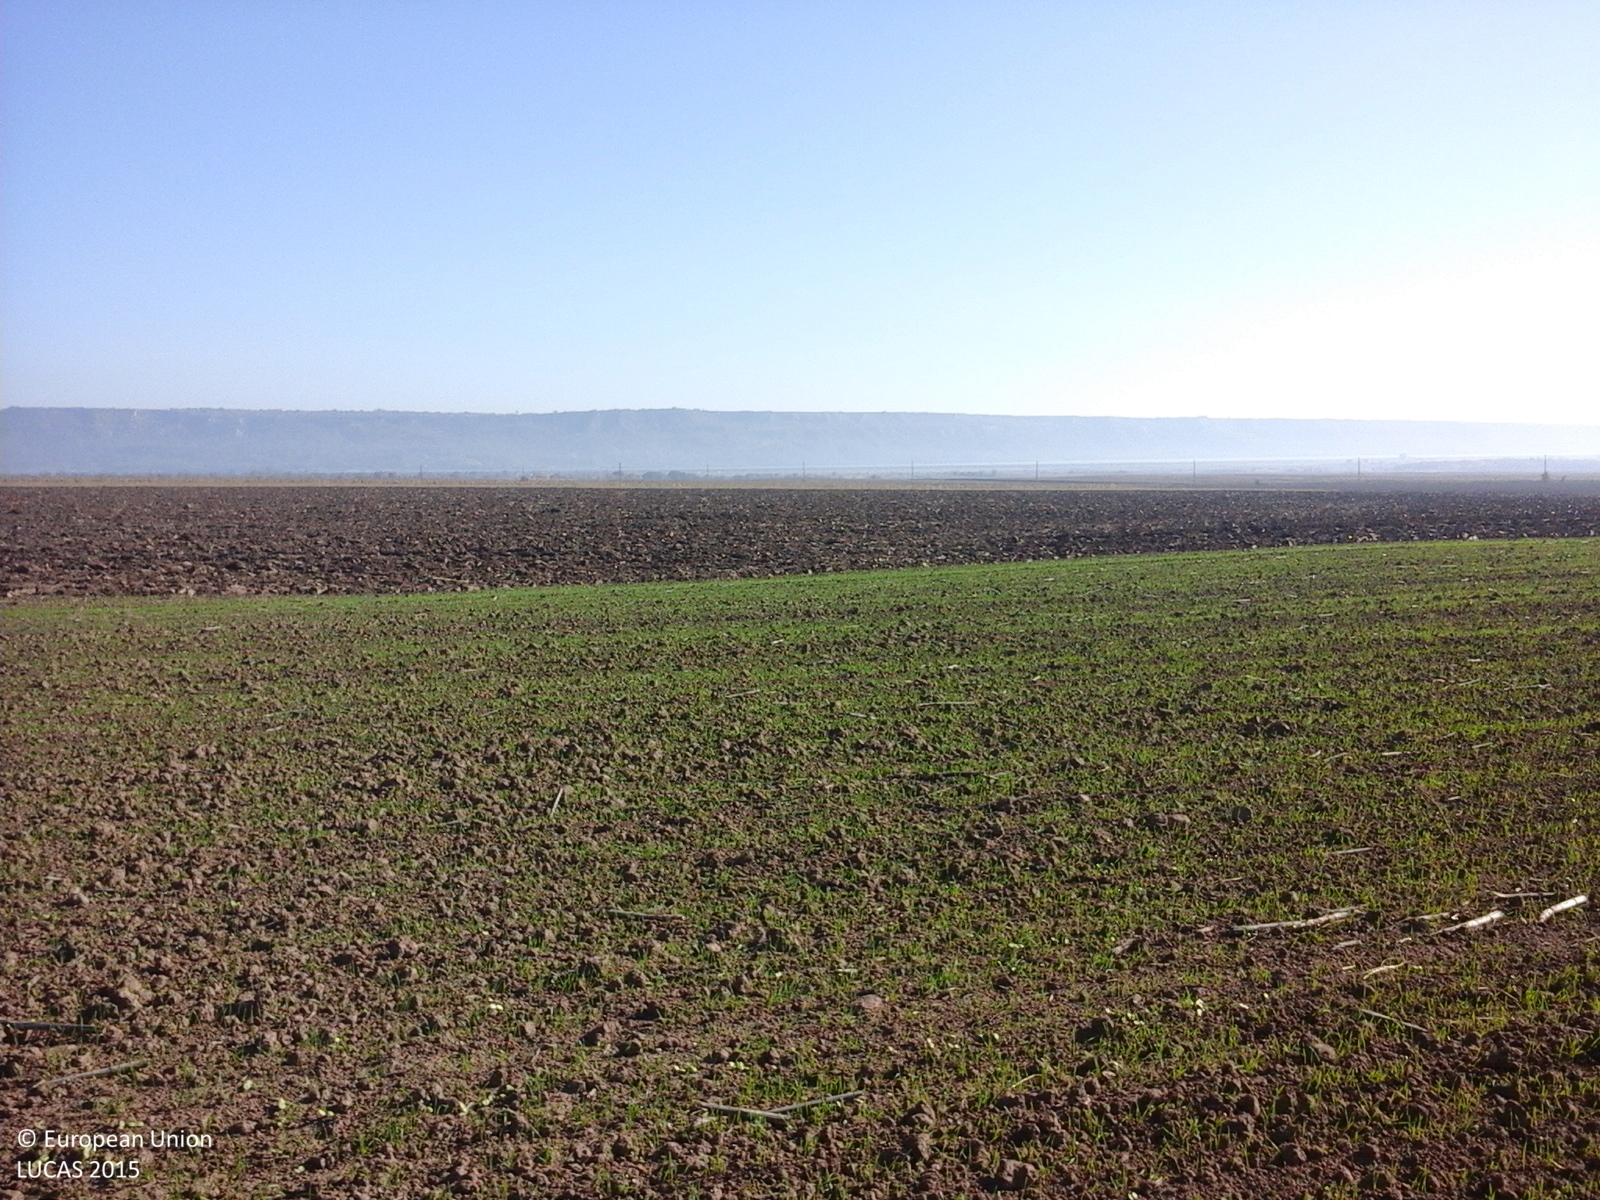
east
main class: Cropland
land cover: Sunflower
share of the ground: 10 - 25 %
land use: Agriculture (excluding fallow land and kitchen gardens)
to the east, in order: Sunflower; Grass margins; Fences; Common wheat; Other bare soil
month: October
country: RO
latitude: 45.9791
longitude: 27.1736
